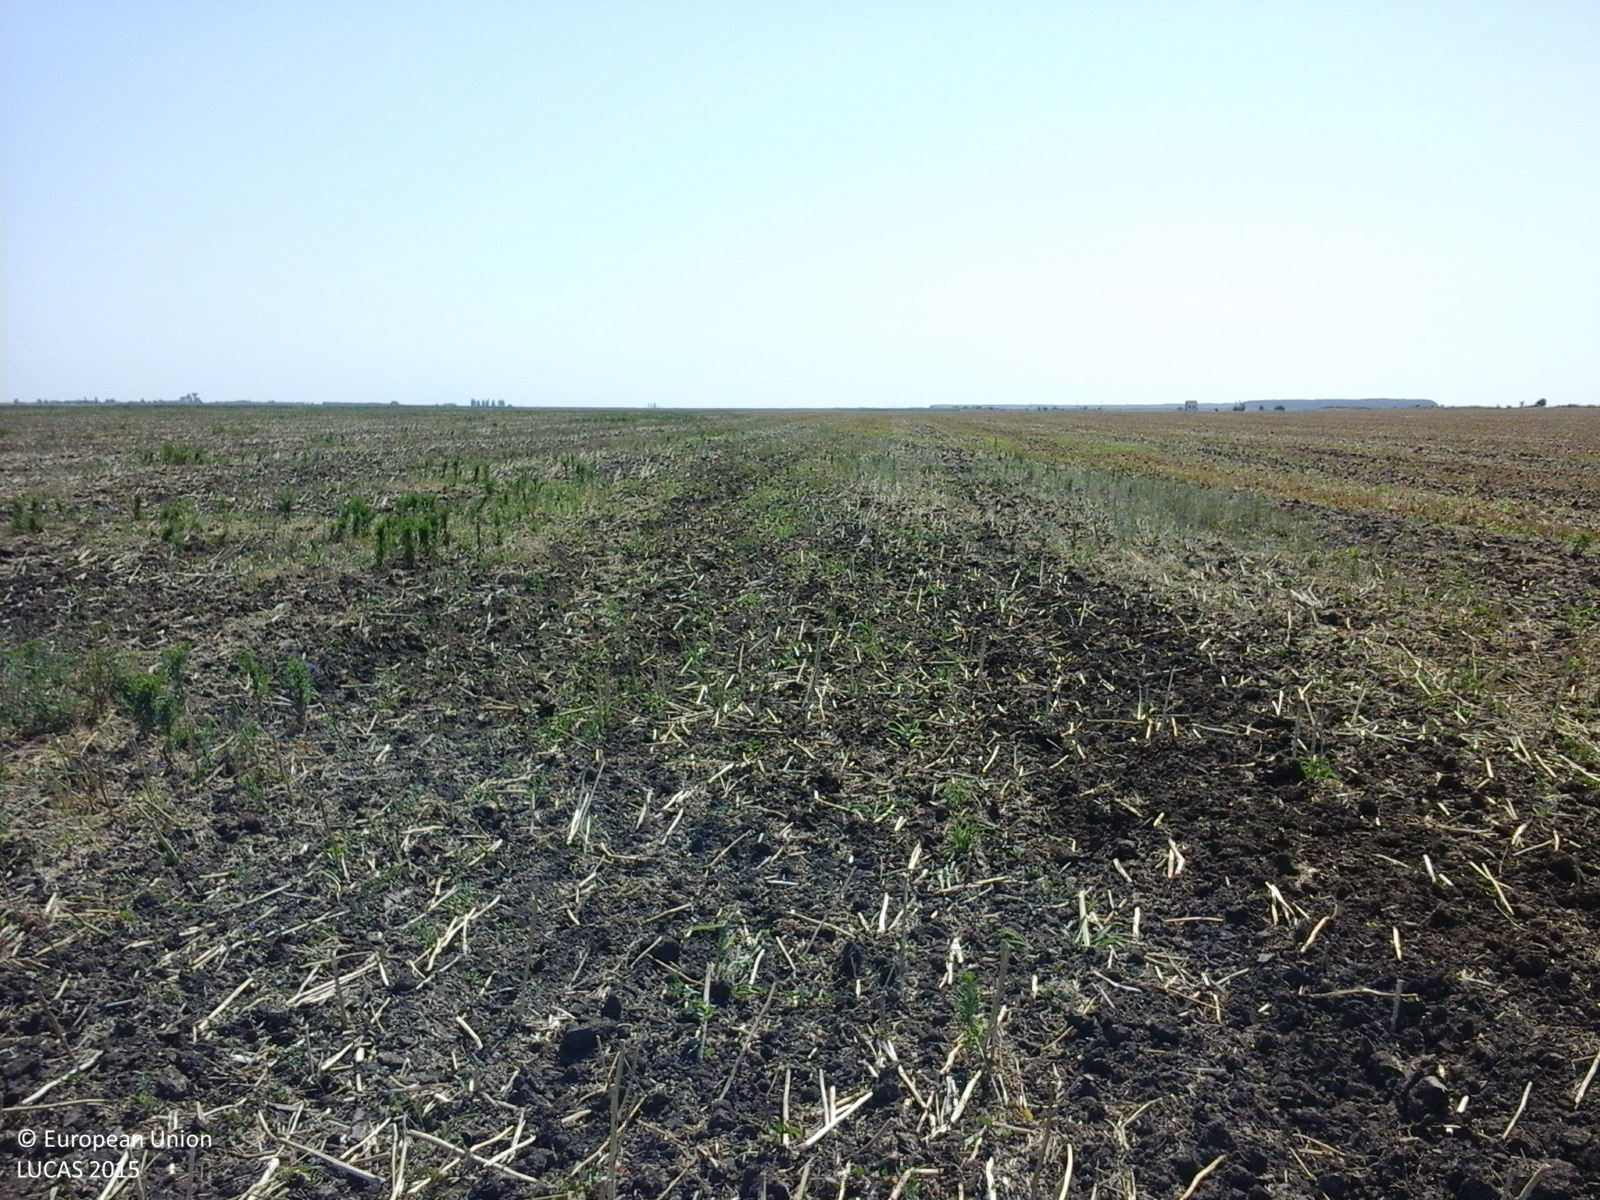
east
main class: Cropland
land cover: Rape and turnip rape
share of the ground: < 10 %
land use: Agriculture (excluding fallow land and kitchen gardens)
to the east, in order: Rape and turnip rape
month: July
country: RO
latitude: 44.4402
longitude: 26.4600
